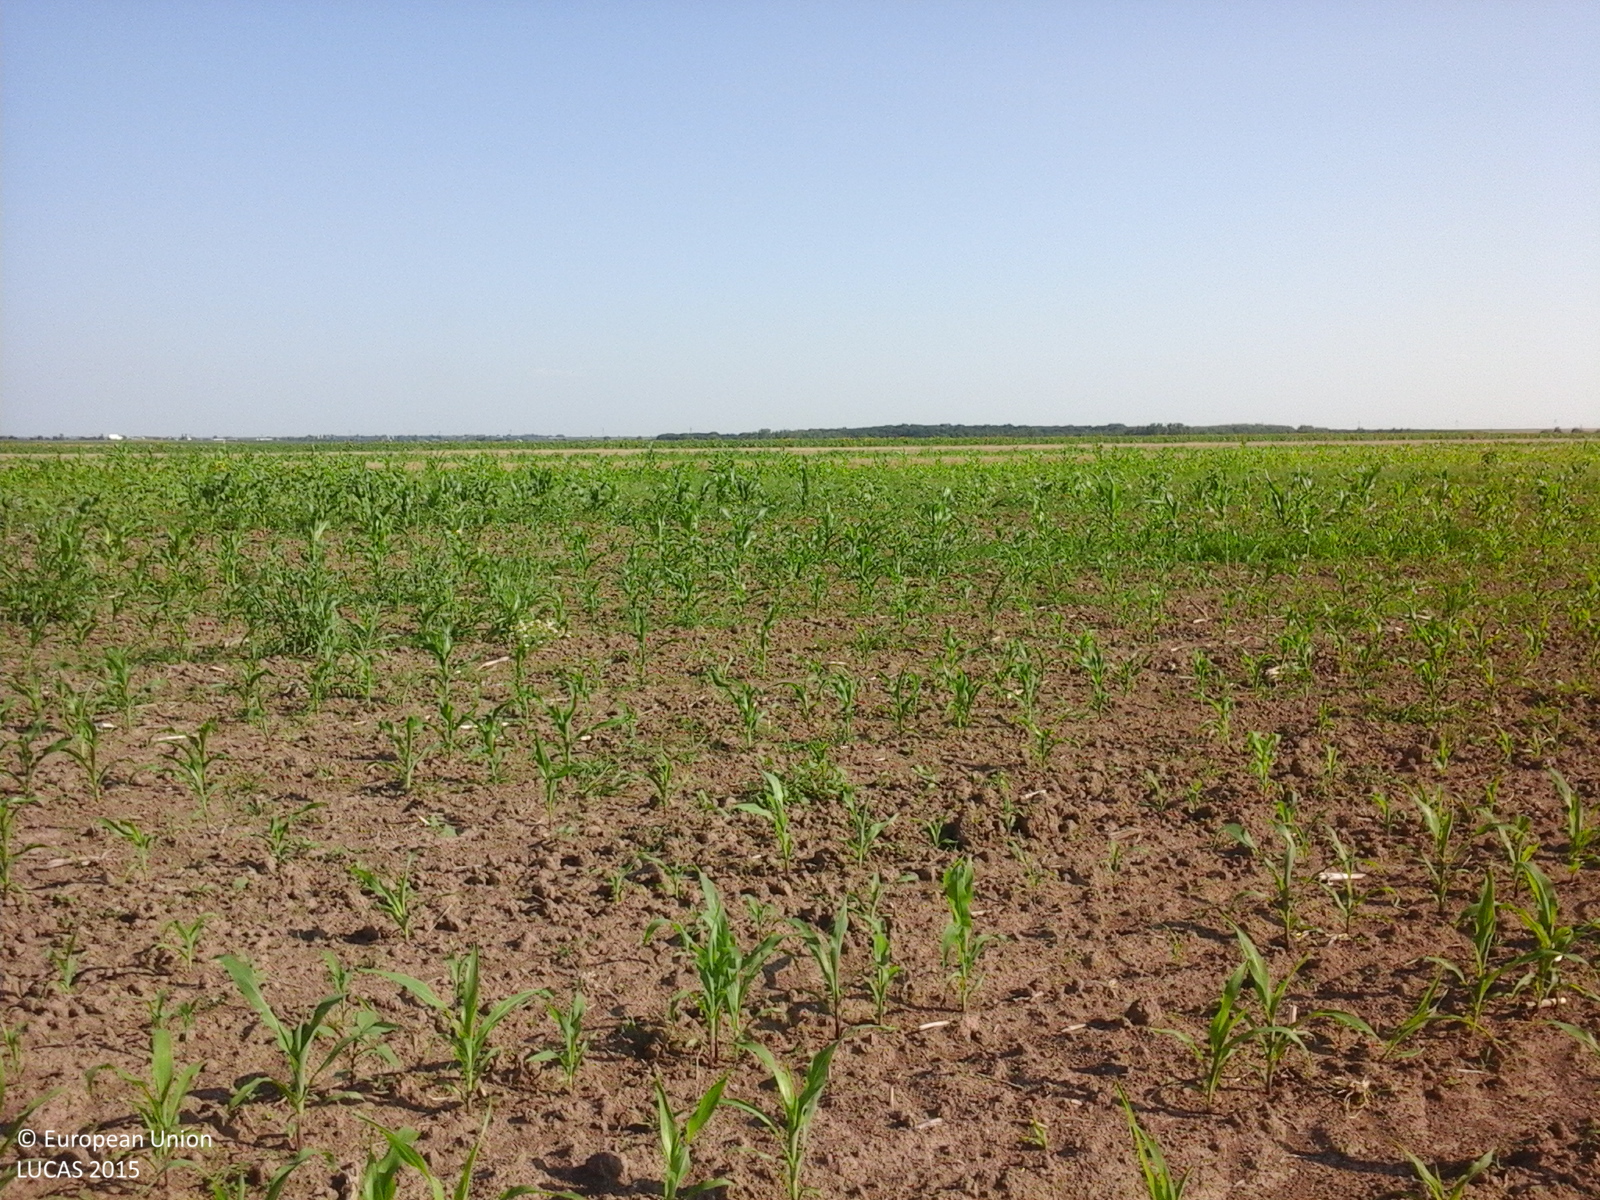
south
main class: Cropland
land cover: Maize
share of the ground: 10 - 25 %
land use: Agriculture (excluding fallow land and kitchen gardens)
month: July
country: RO
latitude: 44.3636
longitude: 24.6661
